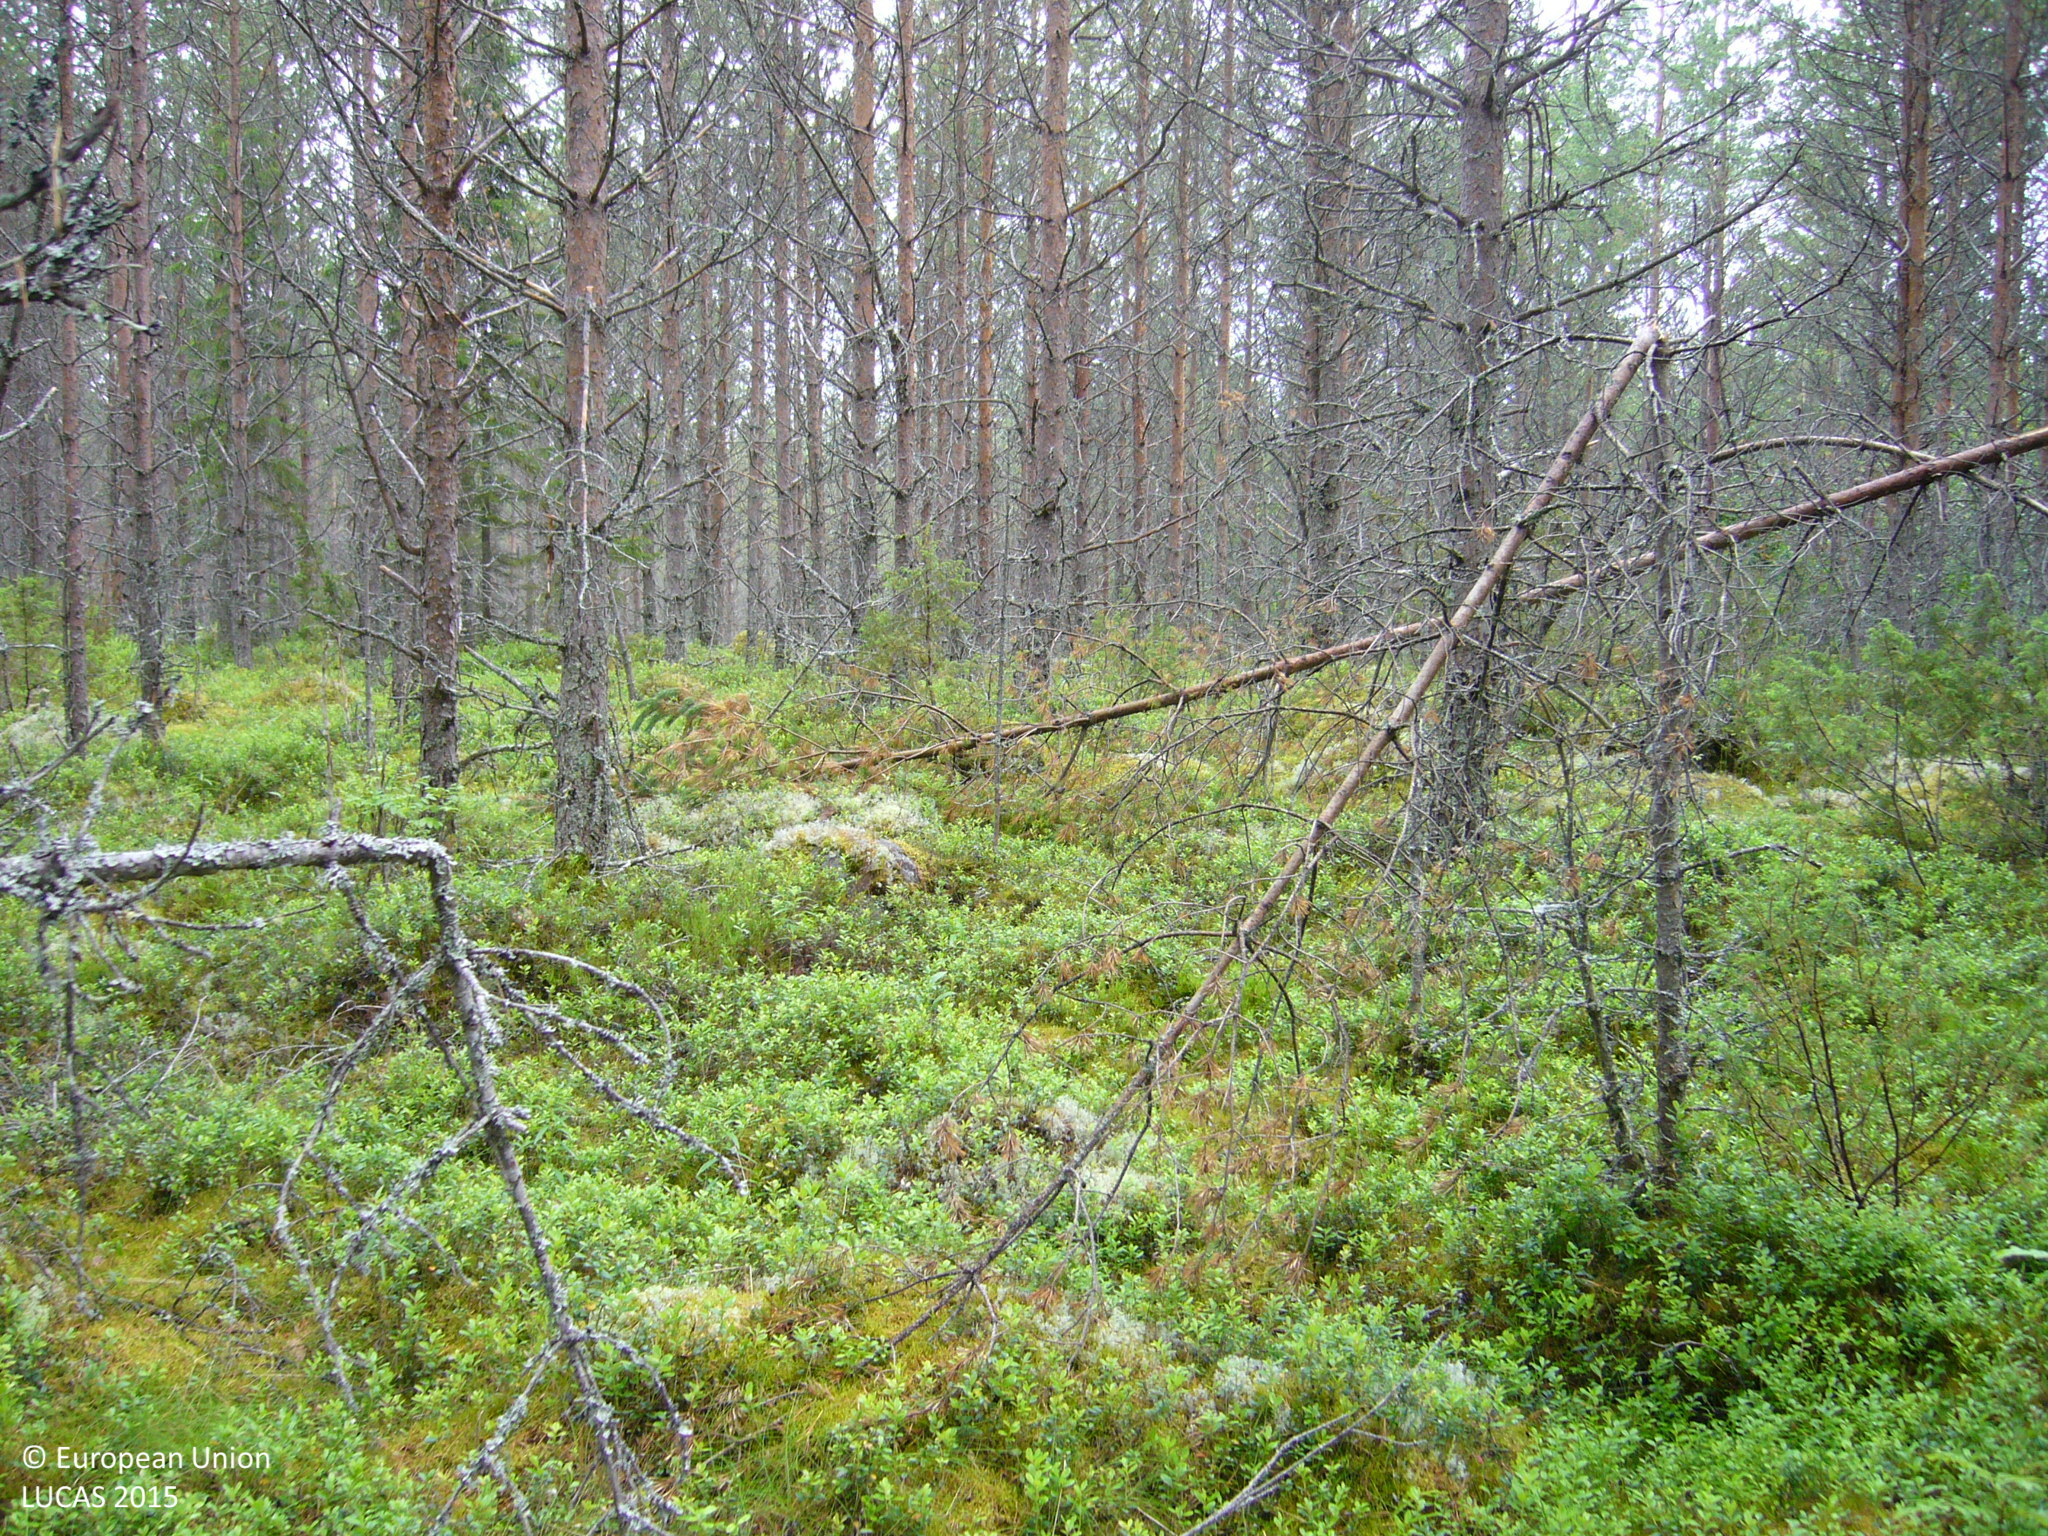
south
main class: Woodland
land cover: Pine dominated coniferous woodland
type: boreal forest
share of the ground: > 75 %
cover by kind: coniferous forest trees 75 %, shrubs 25 %
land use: Forestry
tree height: > 5 m
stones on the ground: > 50 %
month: July
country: FI
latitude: 63.6029
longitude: 25.3997
